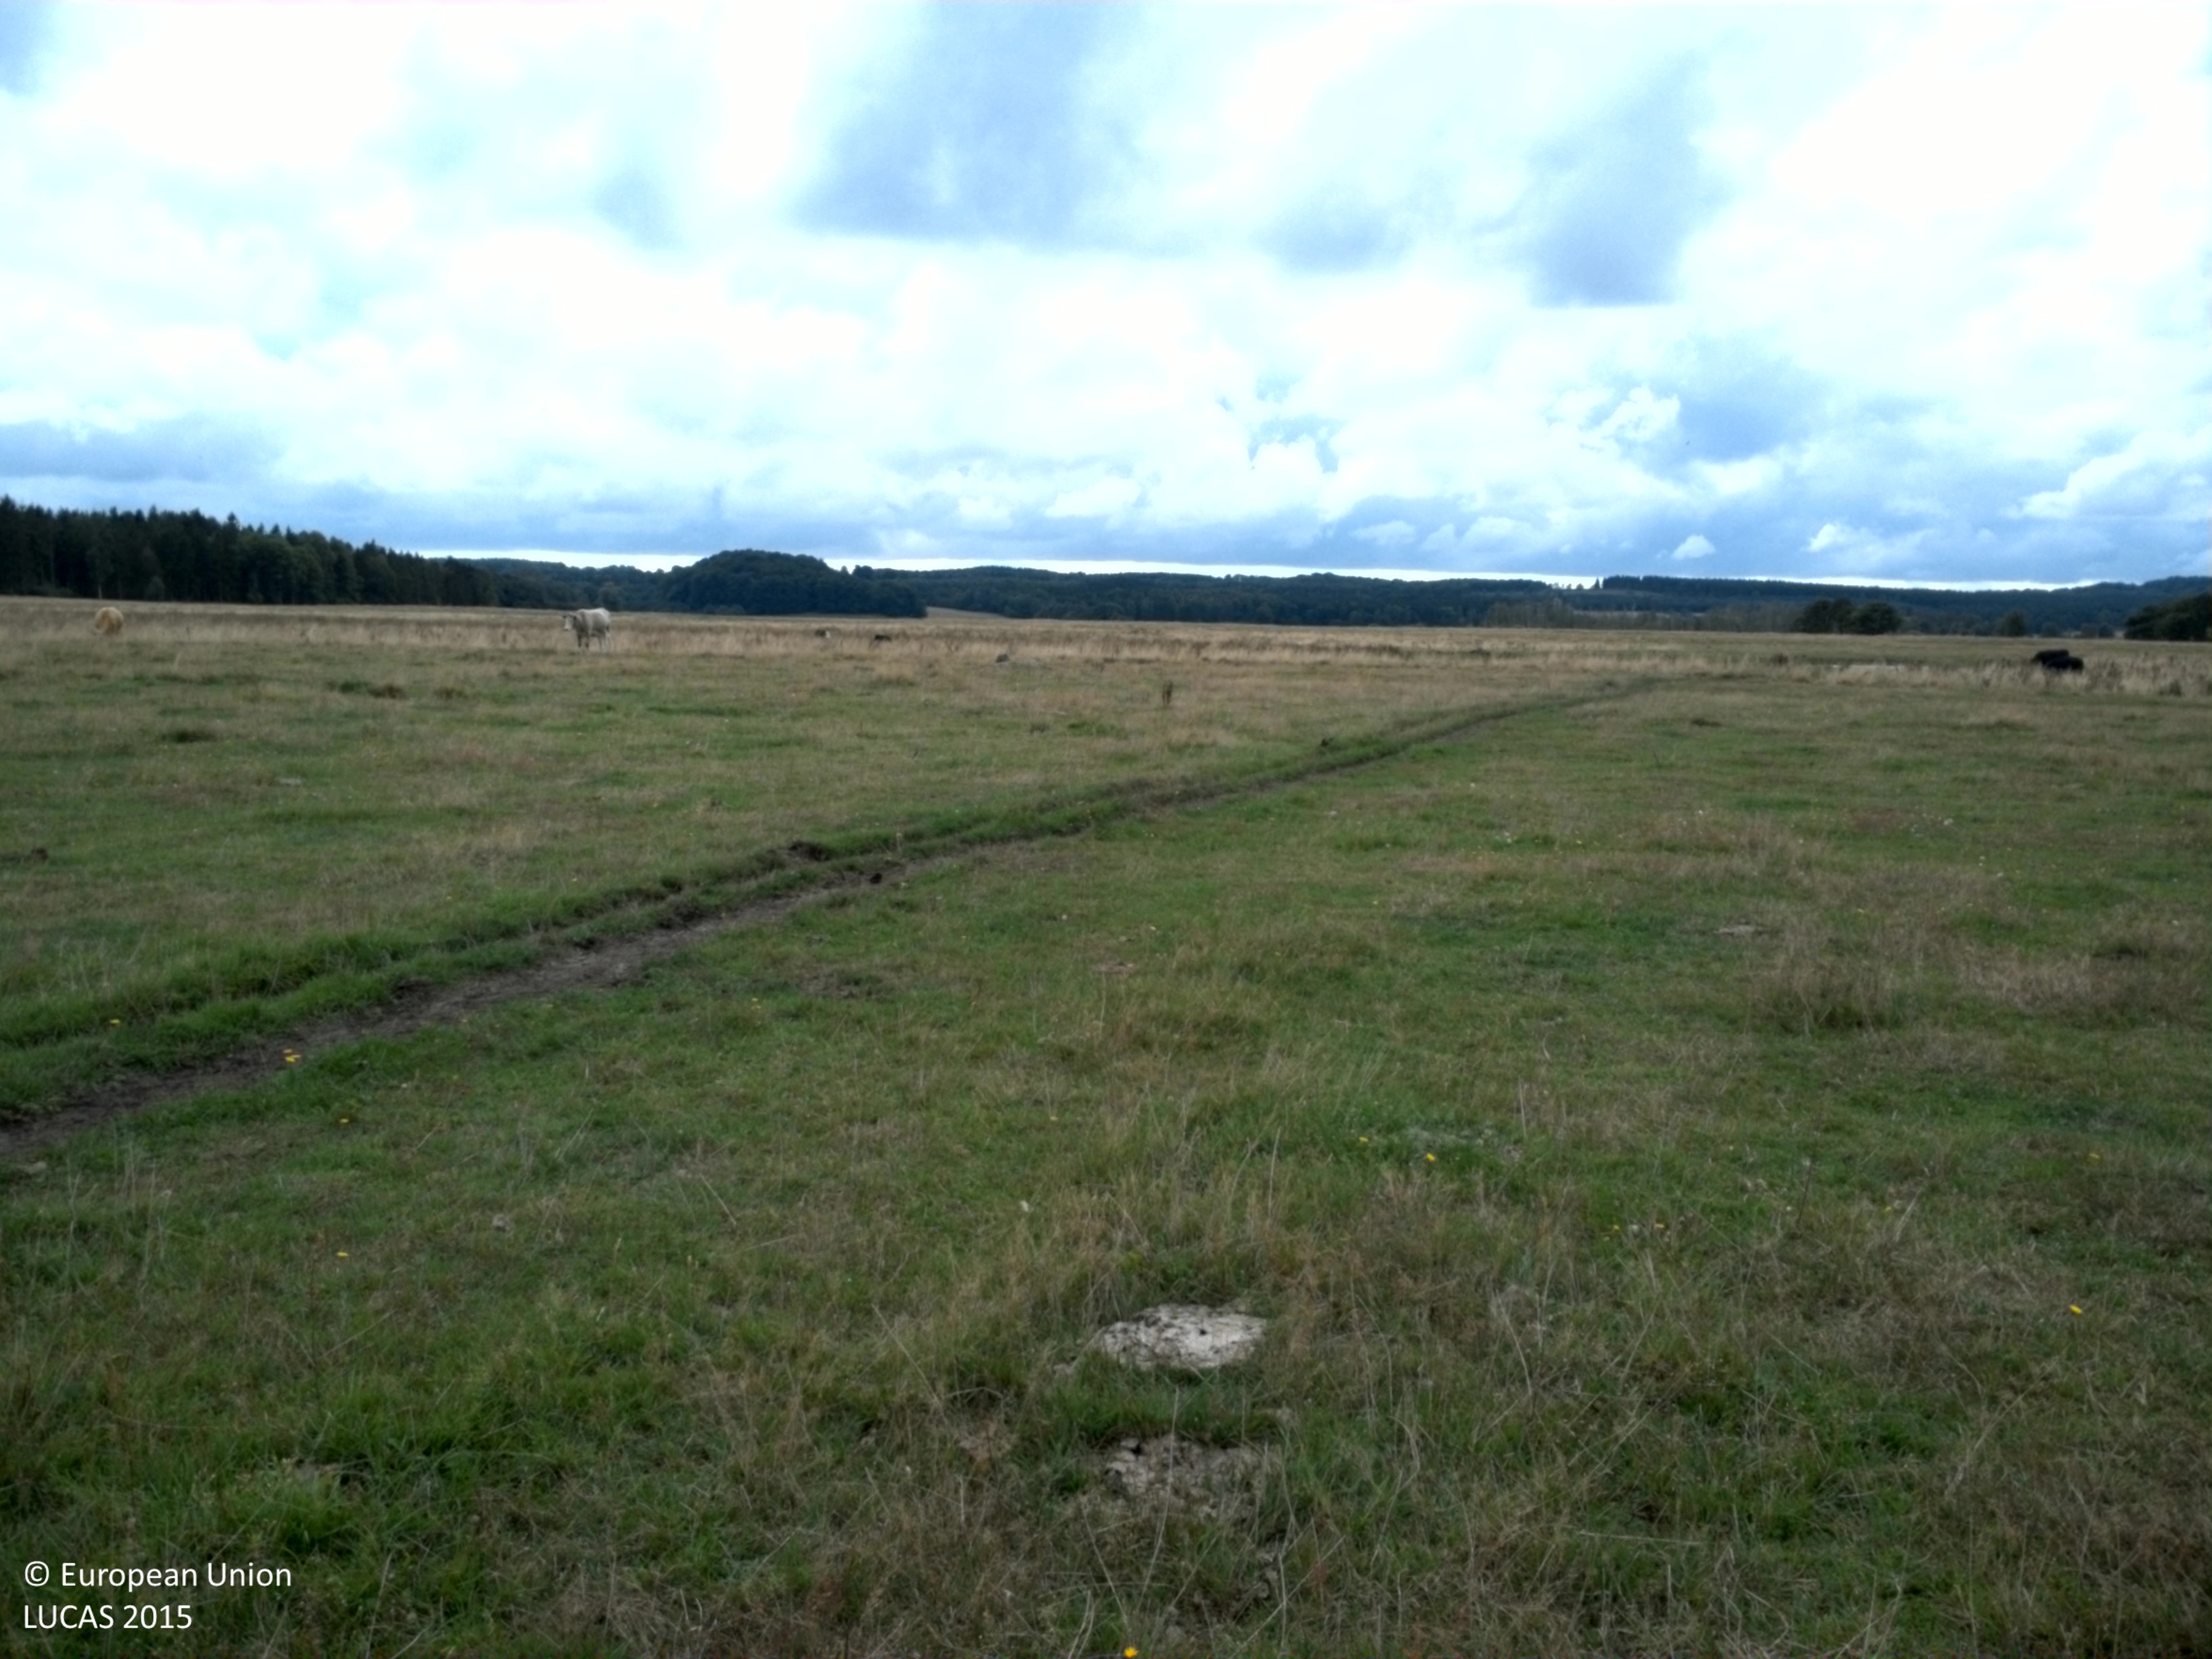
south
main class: Grassland
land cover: Grassland without tree/shrub cover
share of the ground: > 75 %
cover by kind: herbaceous plants 100 %
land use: Agriculture (excluding fallow land and kitchen gardens)
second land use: Amenities, museums, leisure
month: September
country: SE
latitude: 55.5598
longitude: 13.6607
